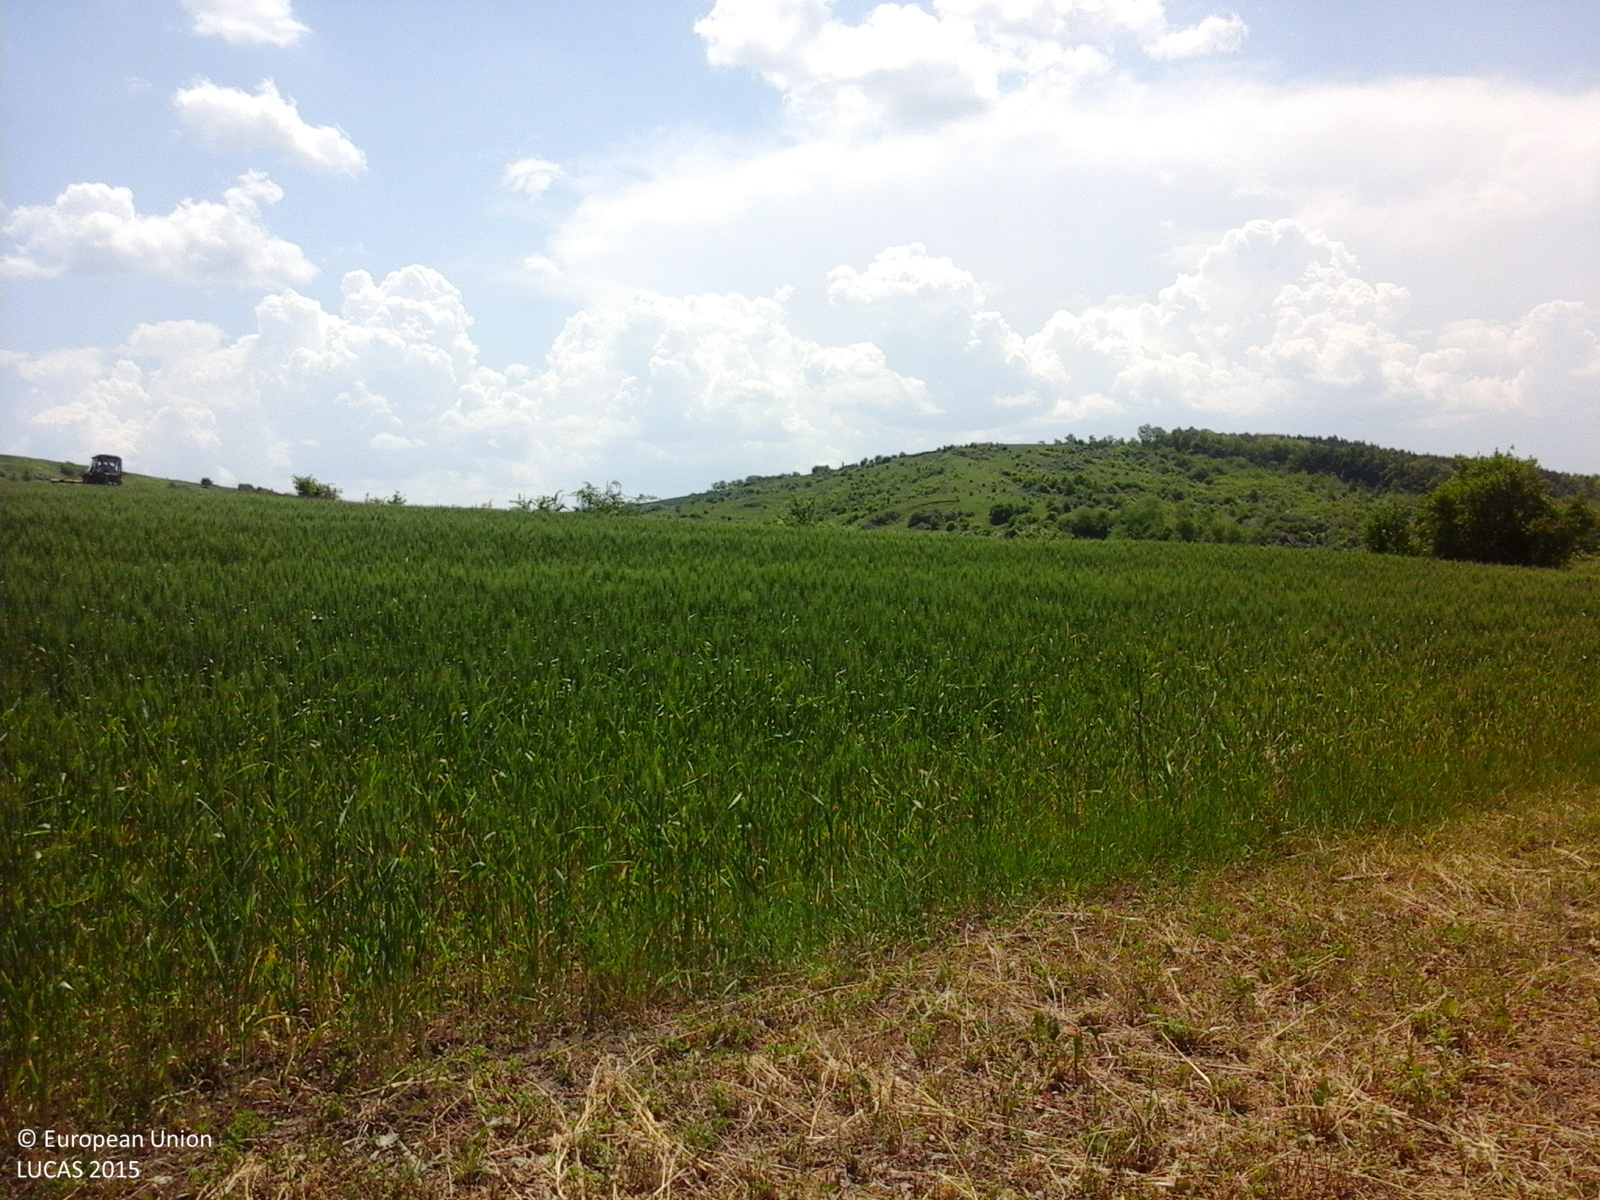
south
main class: Grassland
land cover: Grassland without tree/shrub cover
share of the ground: > 75 %
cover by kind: herbaceous plants 90 %, unconsolidated bare surface 10 %
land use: Agriculture (excluding fallow land and kitchen gardens)
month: June
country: RO
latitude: 46.3015
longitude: 26.7713
